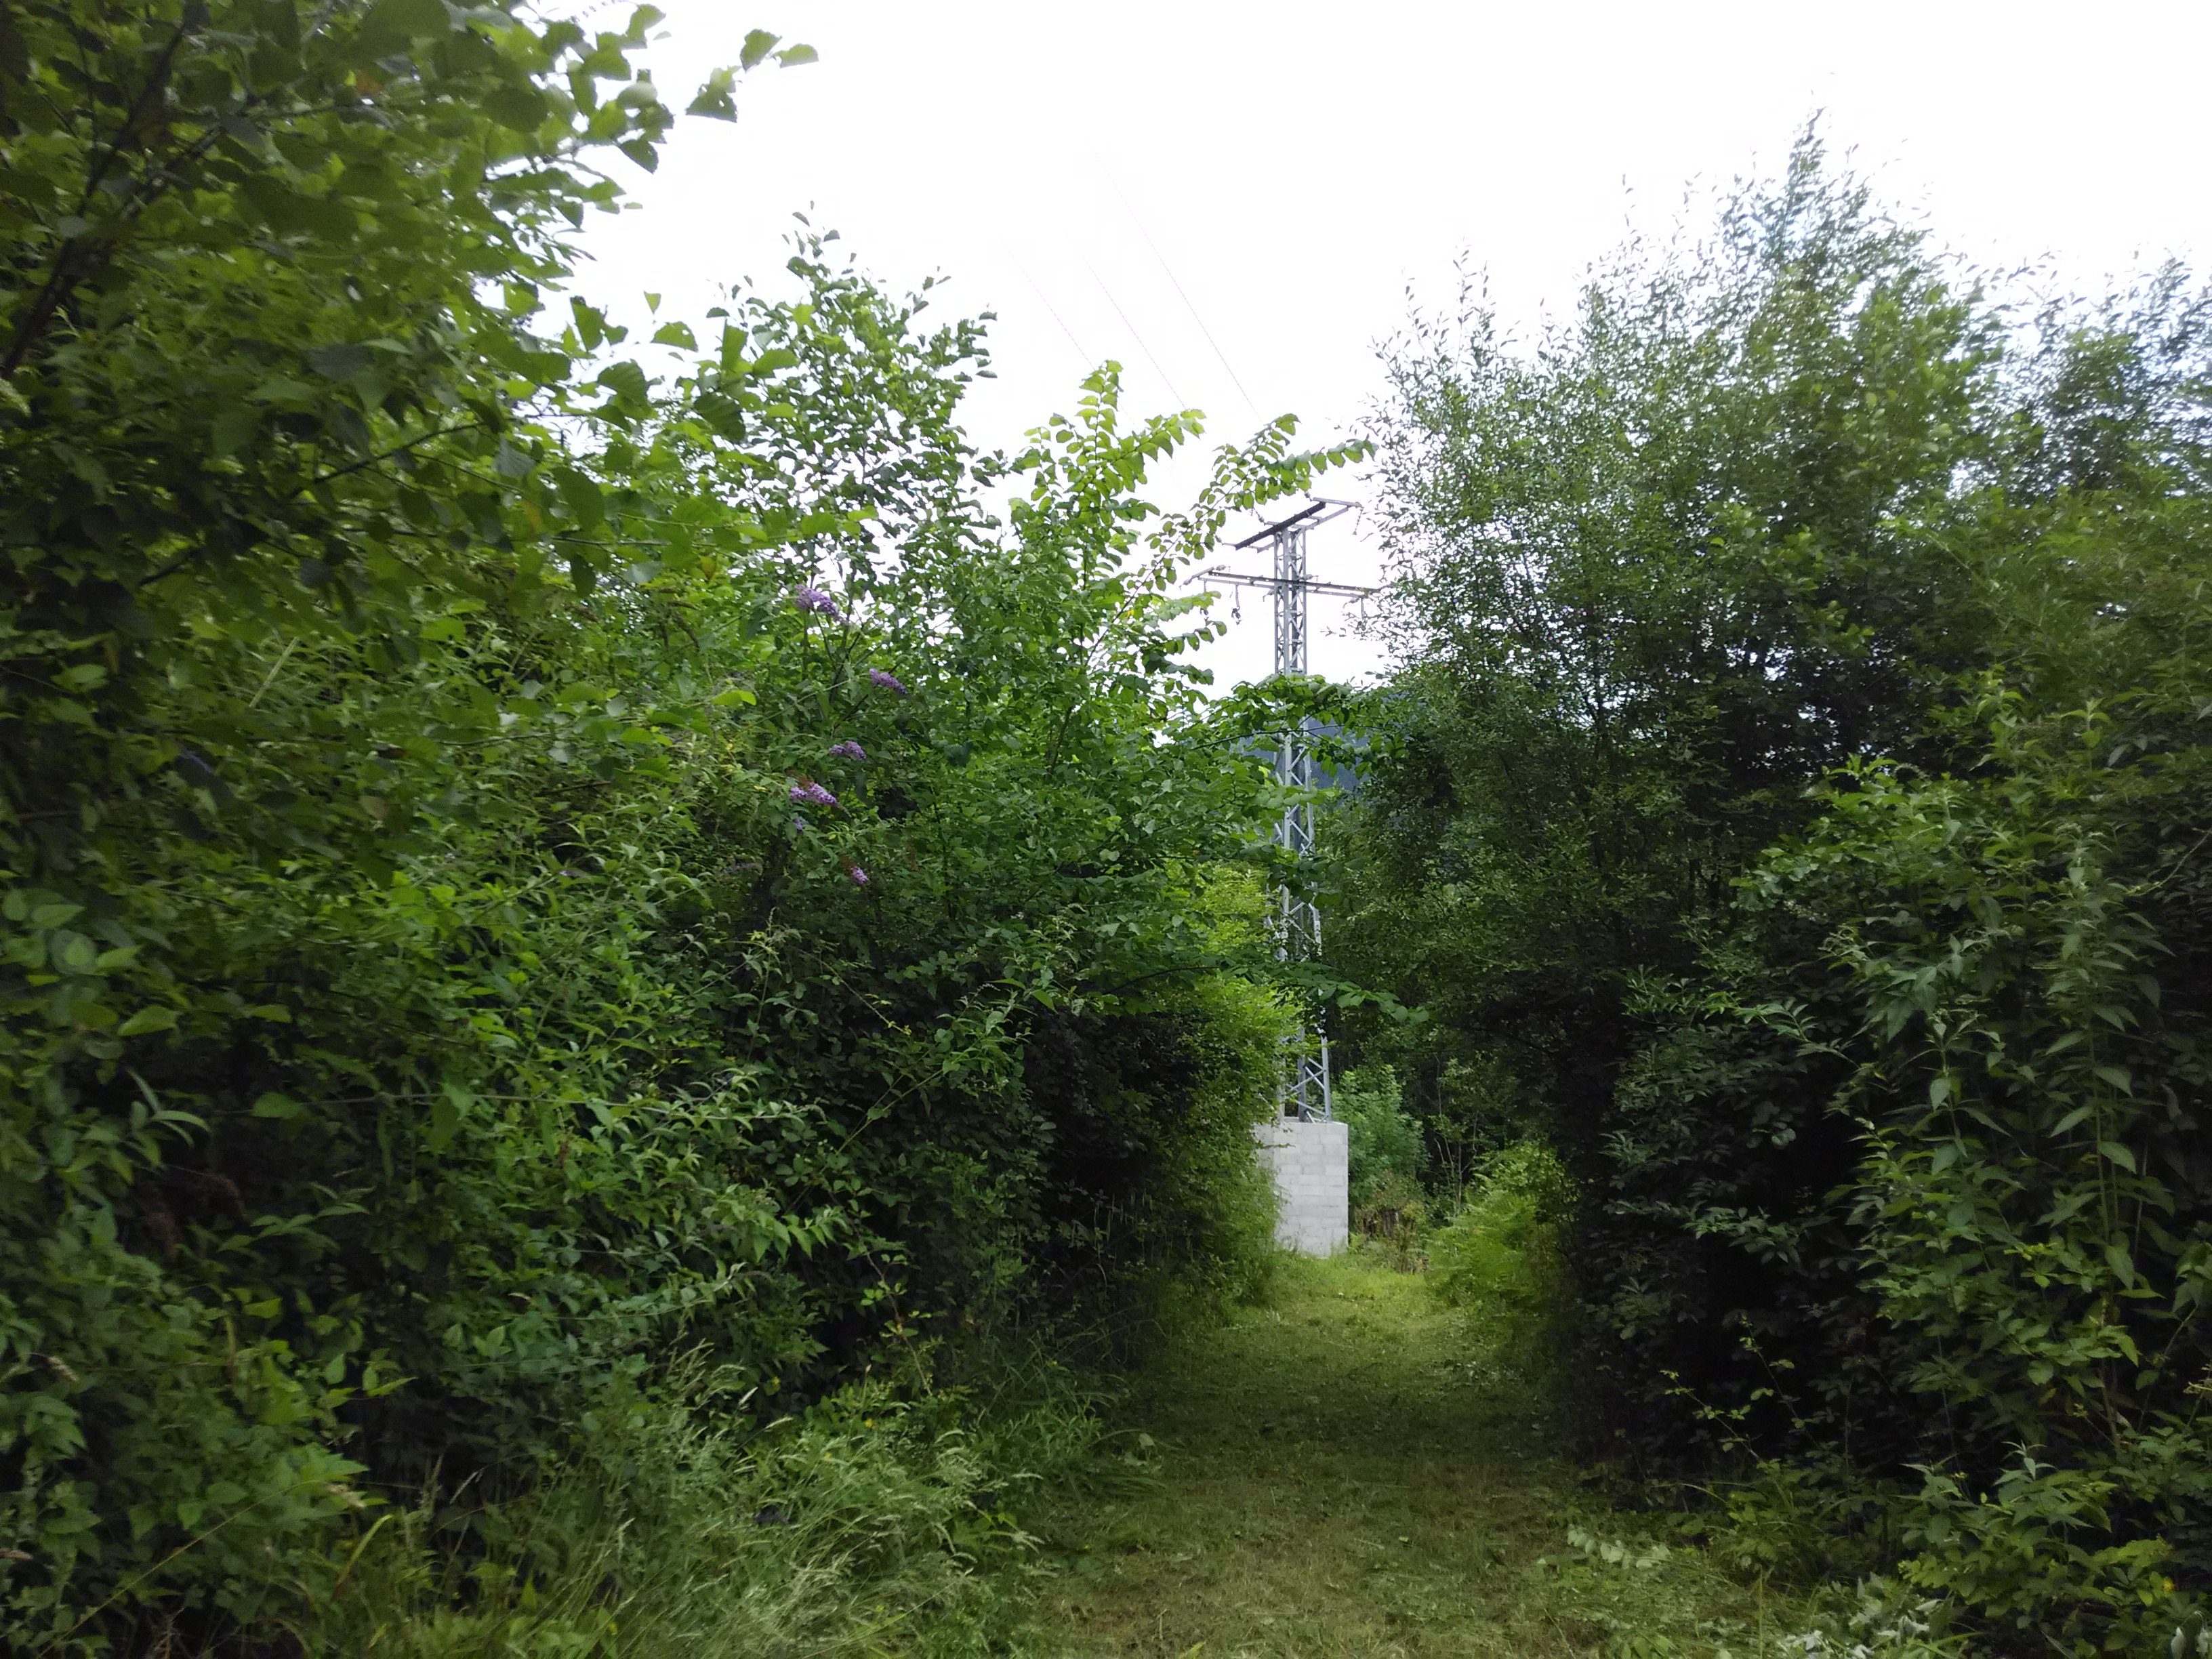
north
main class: Woodland
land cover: Broadleaved woodland
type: beech forest
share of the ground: > 75 %
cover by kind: broadleaved forest trees 100 %
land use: Forestry
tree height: > 5 m
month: July
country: ES
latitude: 43.1733
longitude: -2.4887
